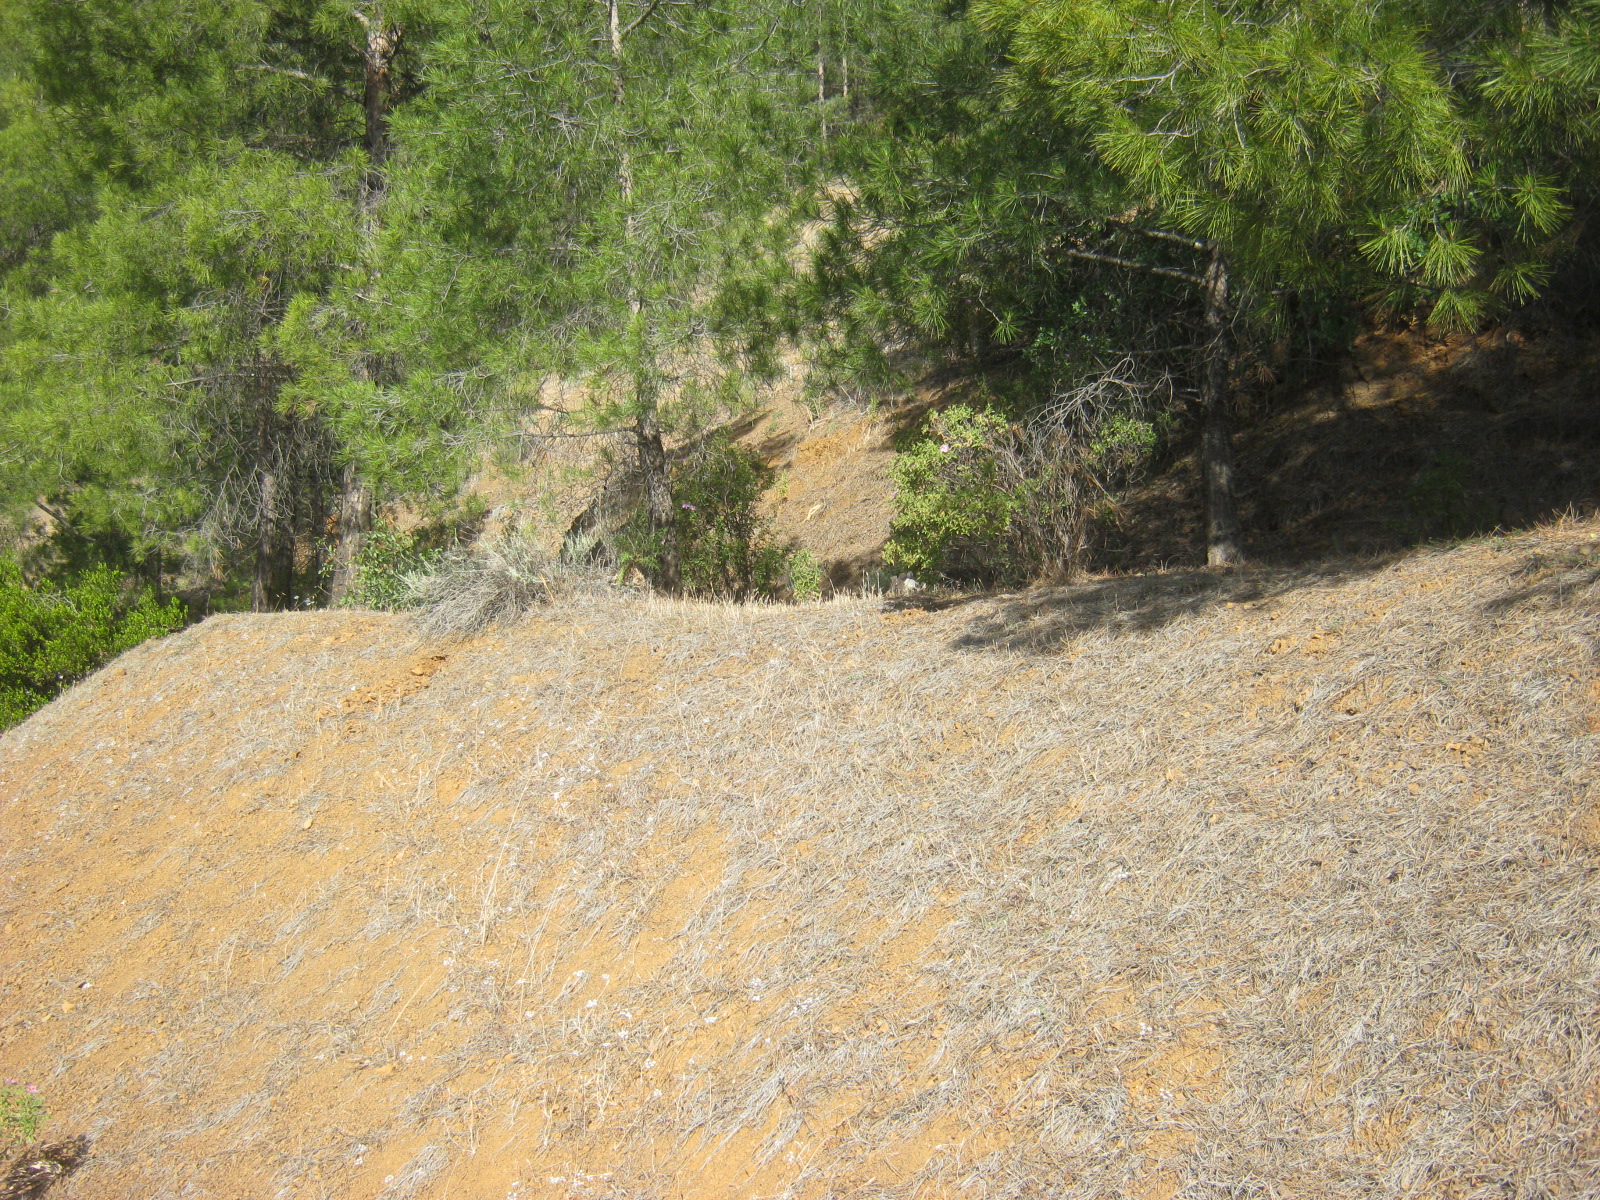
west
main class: Woodland
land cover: Pine dominated coniferous woodland
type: coniferous forest of the mediterranean region
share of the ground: 50 - 75 %
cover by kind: coniferous forest trees 50 %, unconsolidated bare surface 35 %, shrubs 15 %
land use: Forestry
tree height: > 5 m
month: May
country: CY
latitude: 35.0319
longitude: 32.8017
